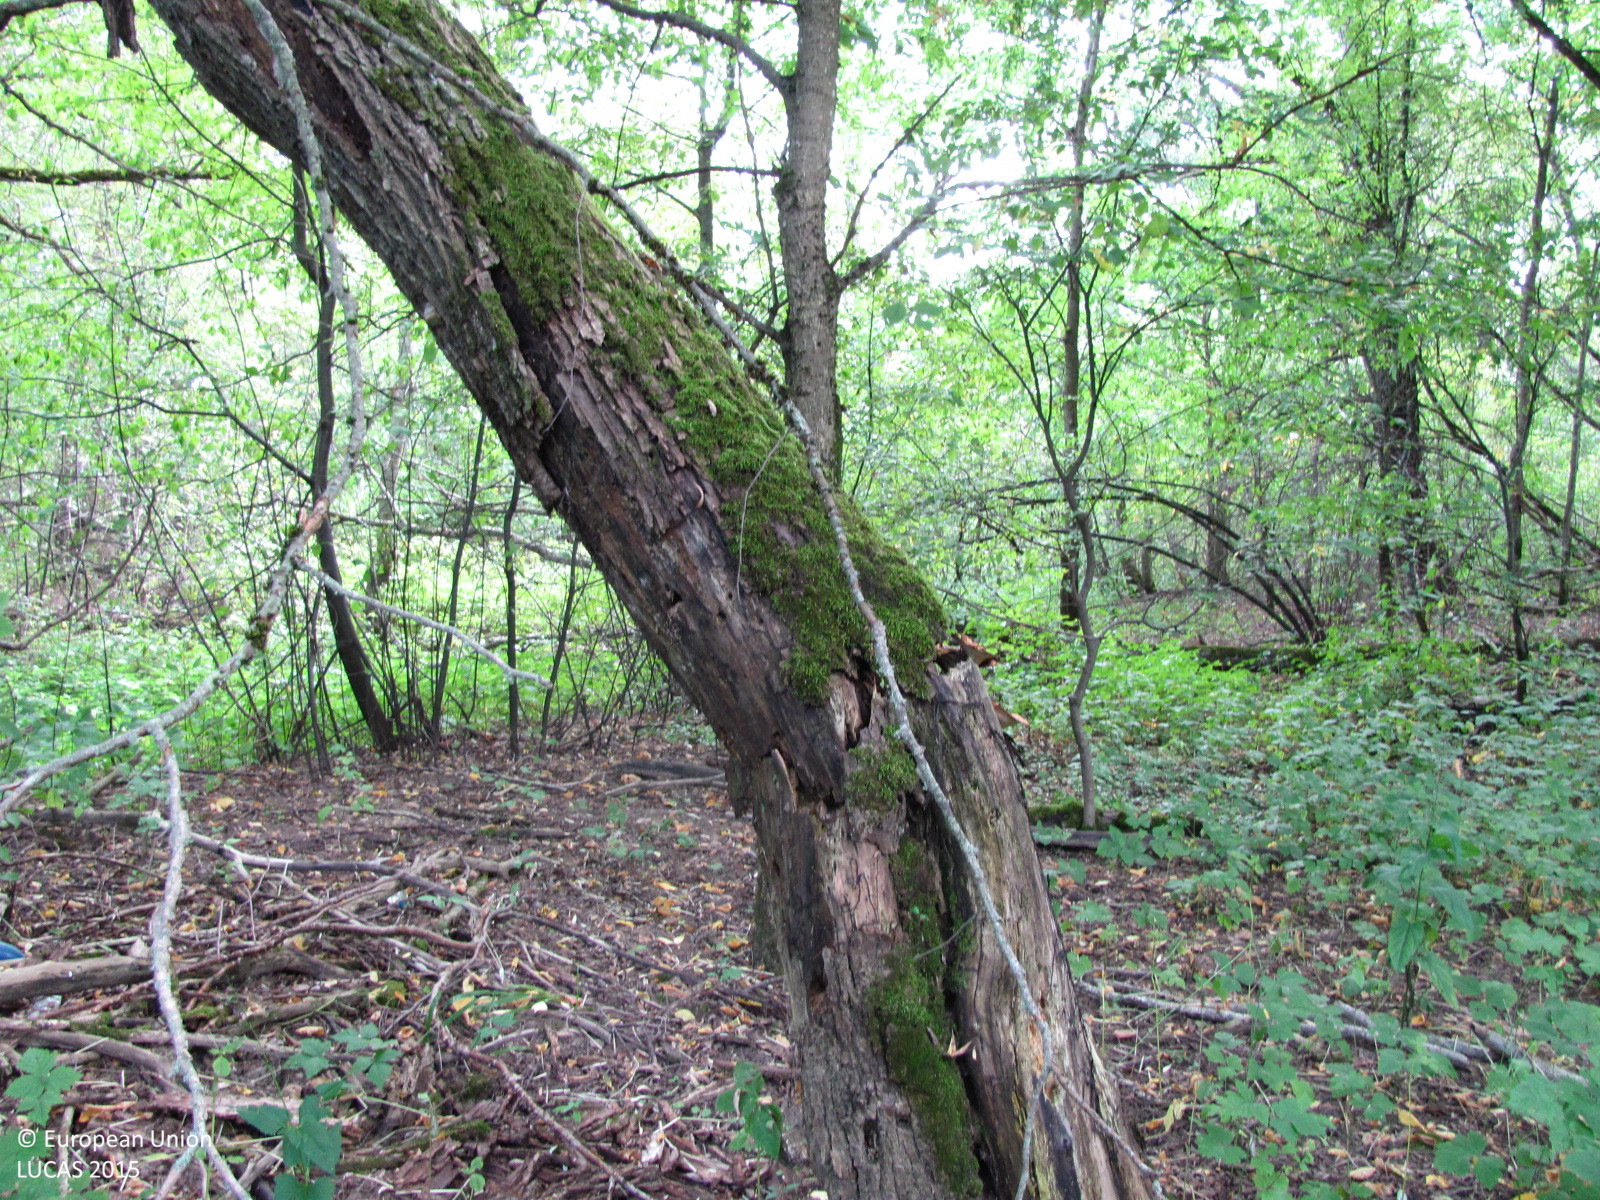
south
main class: Woodland
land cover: Broadleaved woodland
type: floodplain forest
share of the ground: > 75 %
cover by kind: broadleaved forest trees 80 %, herbaceous plants 15 %, unconsolidated bare surface 5 %
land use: Semi-natural and natural areas not in use
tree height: > 5 m
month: September
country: LV
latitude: 57.0975
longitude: 24.3341
